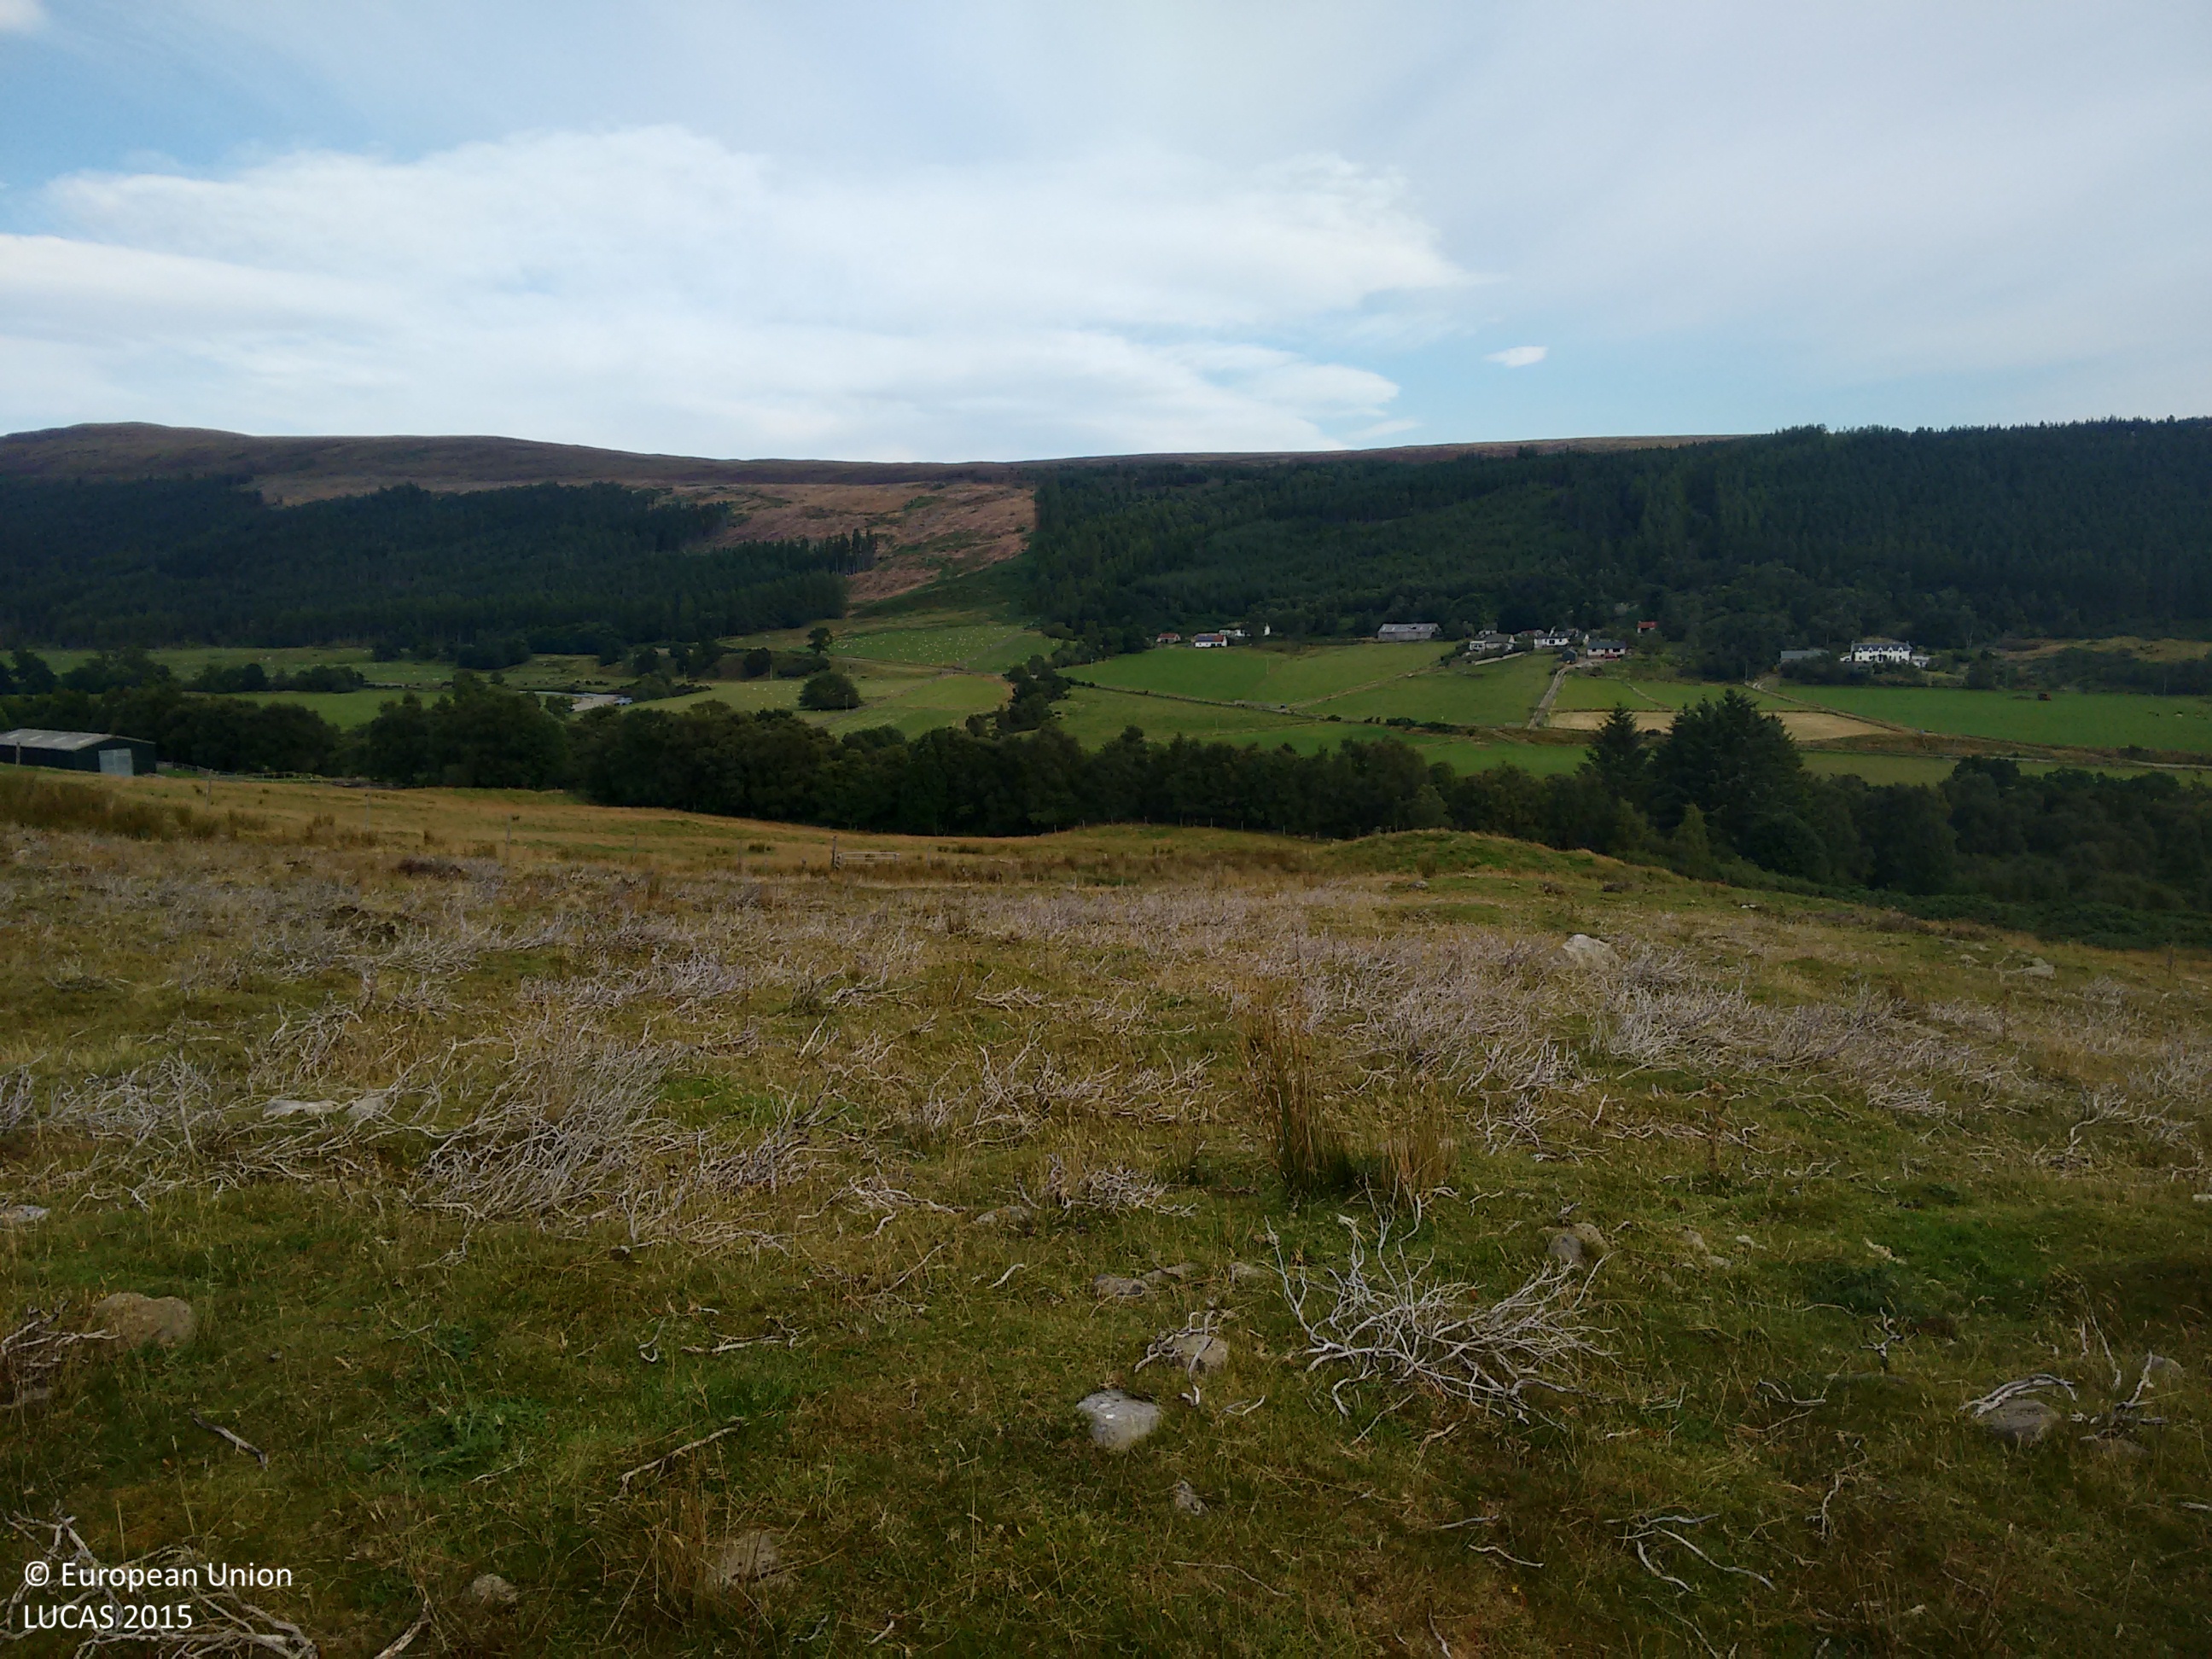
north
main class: Grassland
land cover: Grassland without tree/shrub cover
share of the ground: > 75 %
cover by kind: herbaceous plants 95 %, shrubs 5 %
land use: Agriculture (excluding fallow land and kitchen gardens)
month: September
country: GB
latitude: 57.8879
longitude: -4.4755
